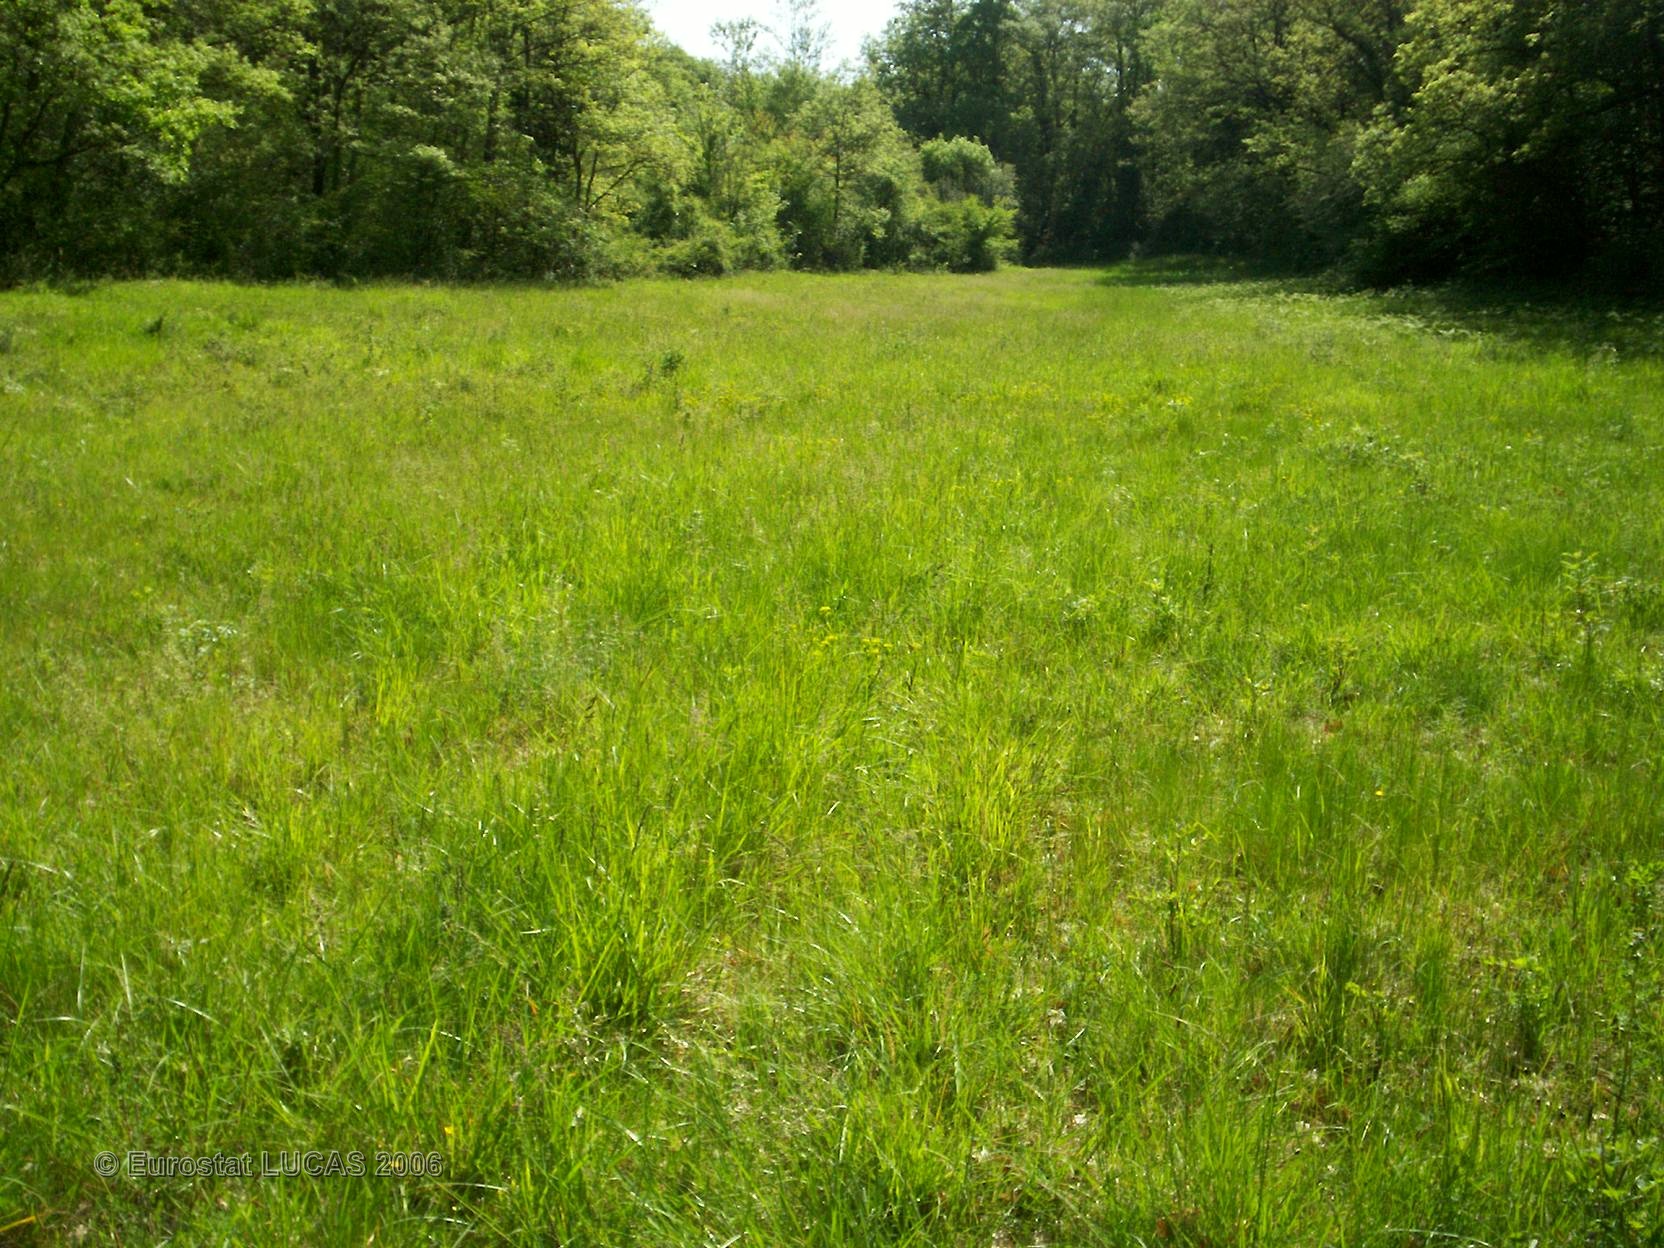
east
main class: Grassland
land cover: Grassland without tree/shrub cover
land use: Agriculture (excluding fallow land and kitchen gardens)
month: May
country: FR
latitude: 43.8008
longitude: 0.2624
